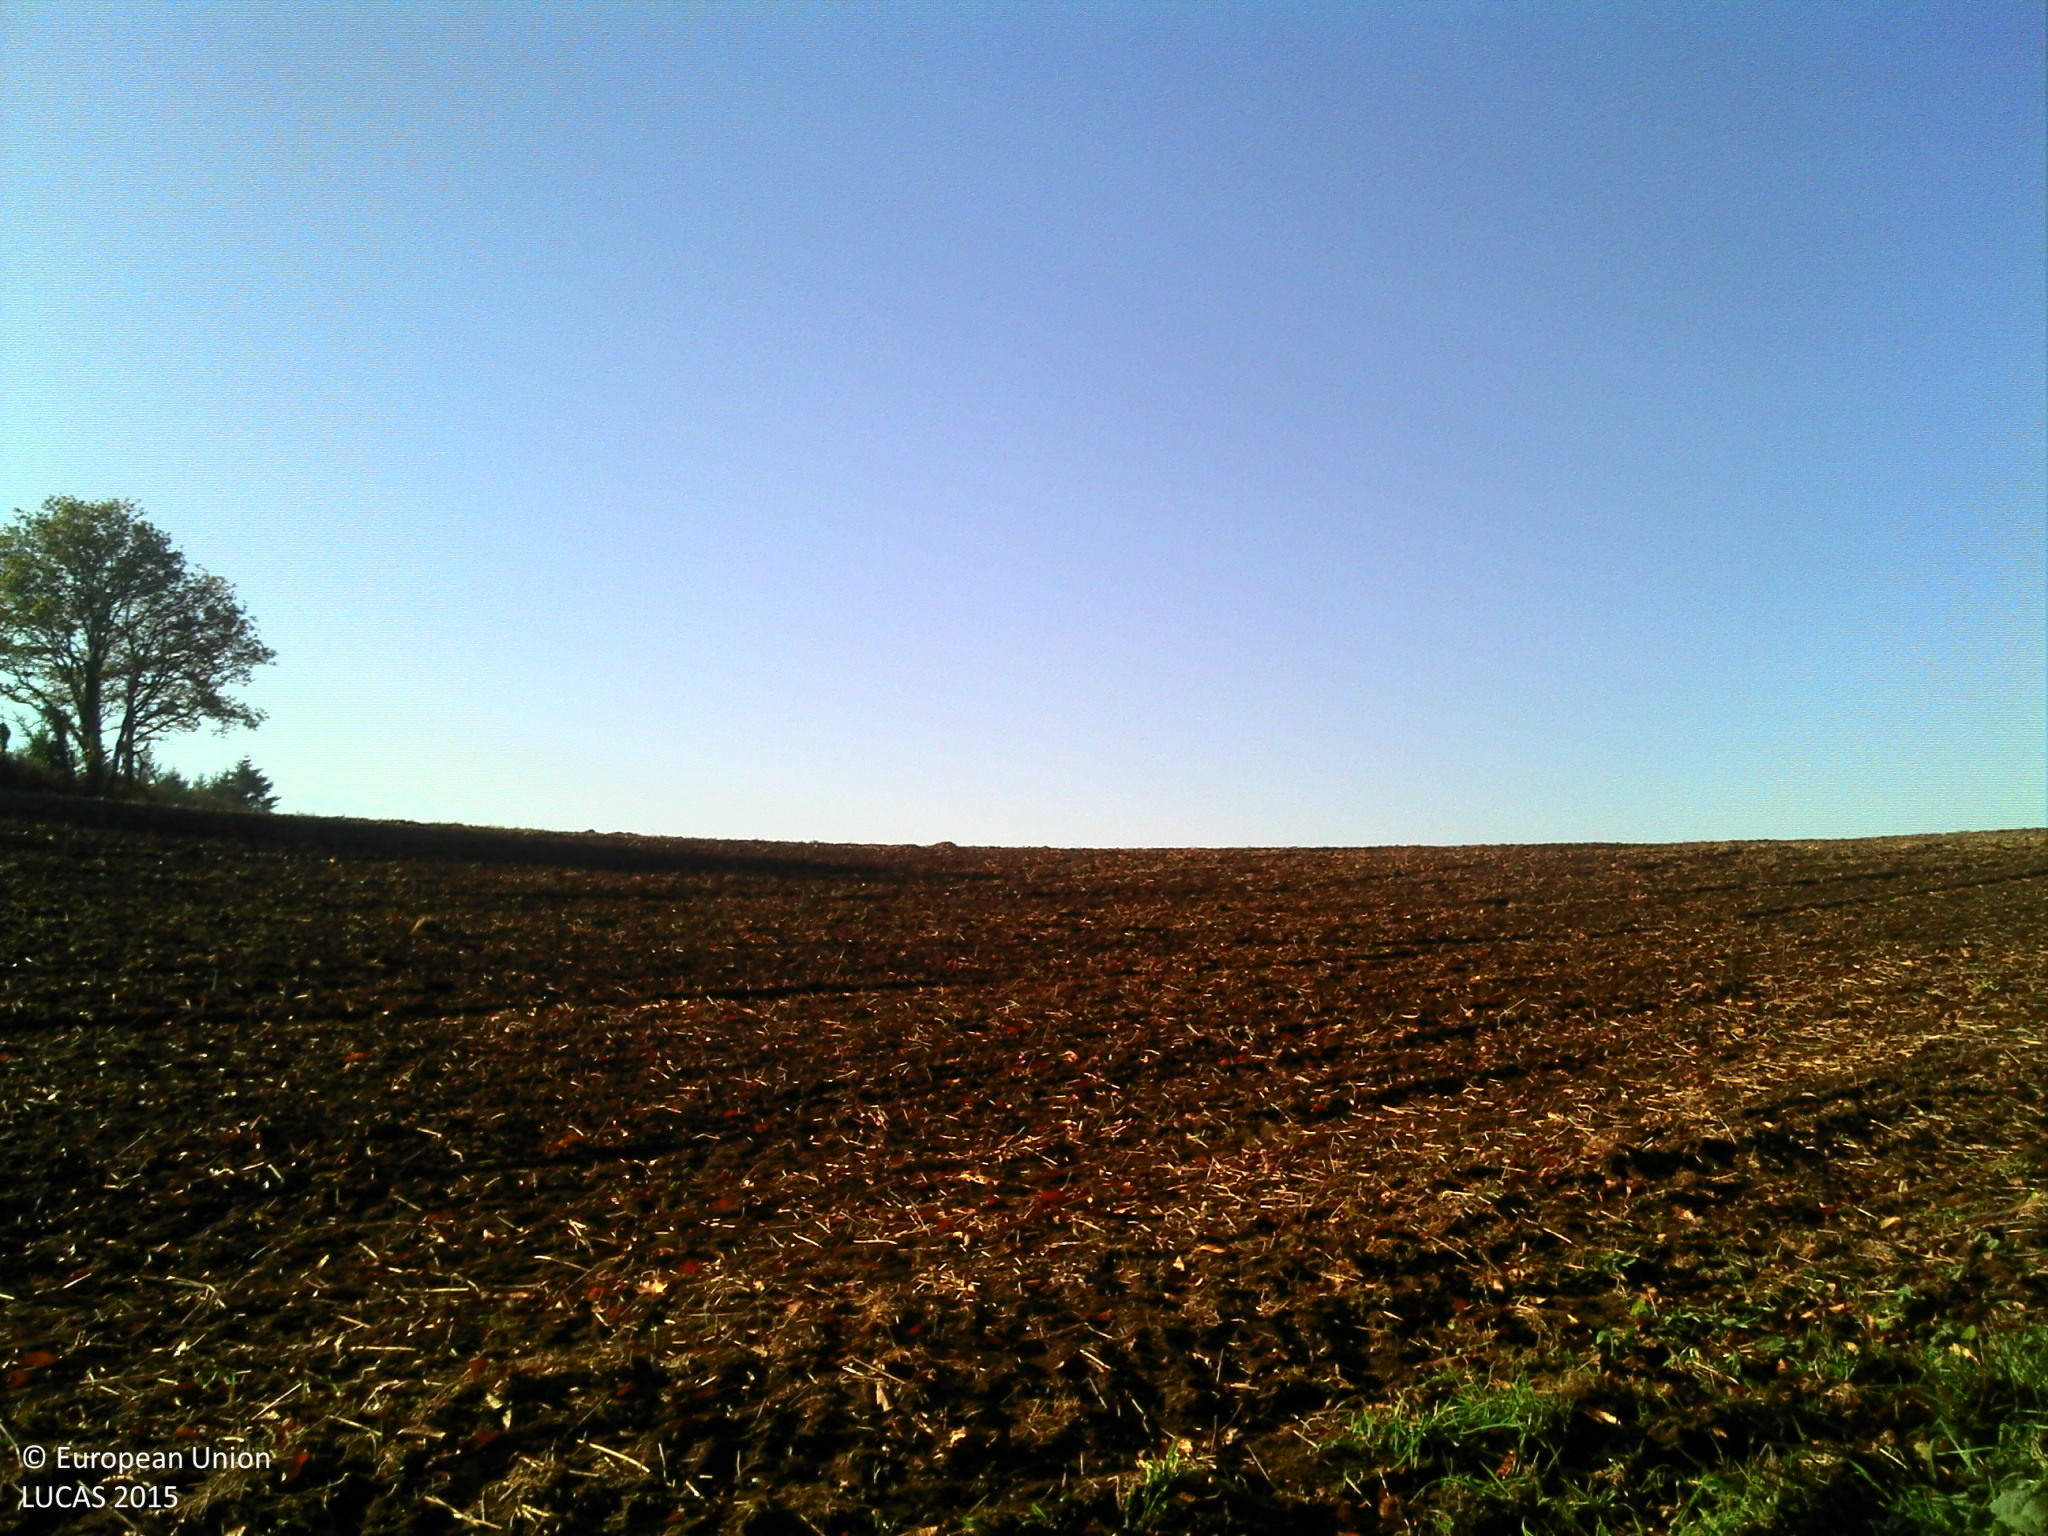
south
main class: Woodland
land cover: Broadleaved woodland
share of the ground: > 75 %
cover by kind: broadleaved forest trees 100 %
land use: Forestry
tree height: > 5 m
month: November
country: FR
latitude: 48.1091
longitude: -3.2757
